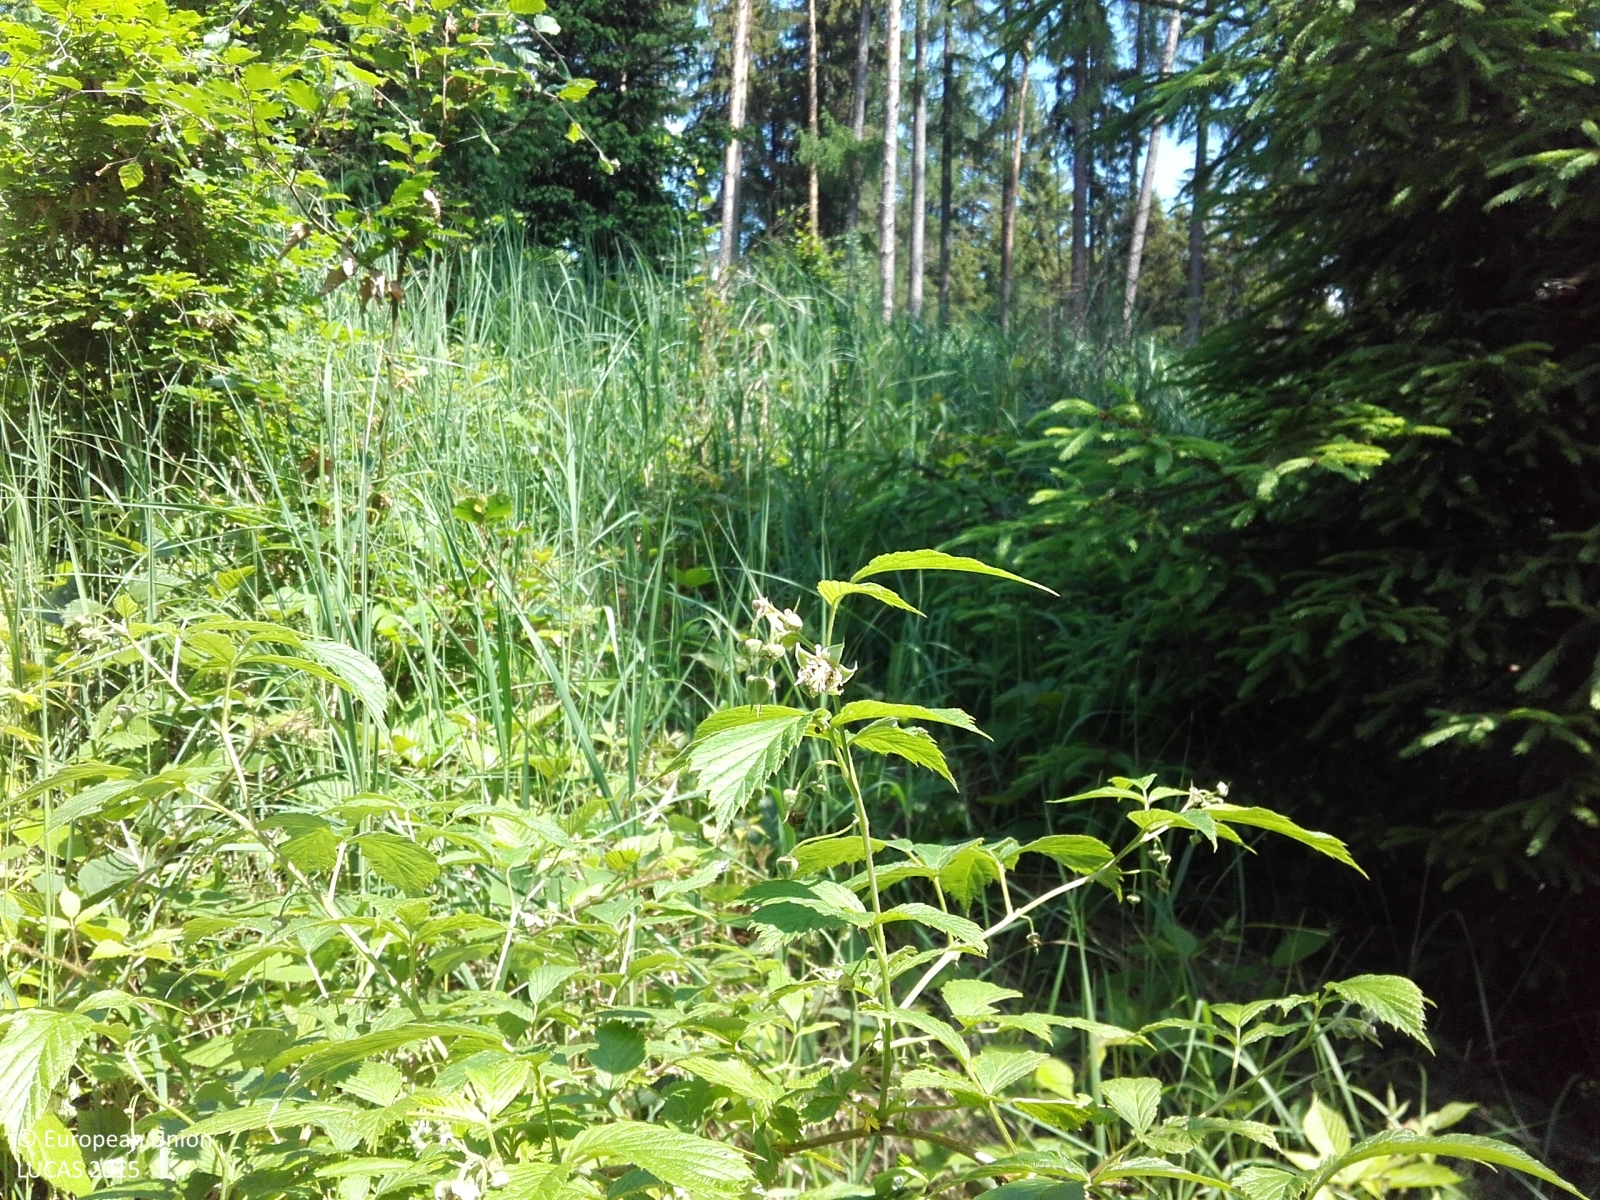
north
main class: Woodland
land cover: Spruce dominated coniferous woodland
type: hemiboreal forest and nemoral coniferous forest and mixed broadleaved-coniferous forest
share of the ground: > 75 %
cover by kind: coniferous forest trees 85 %, shrubs 5 %, herbaceous plants 5 %, lichens and mosses 5 %
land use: Forestry
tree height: > 5 m
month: June
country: CZ
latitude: 49.6686
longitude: 17.7312
